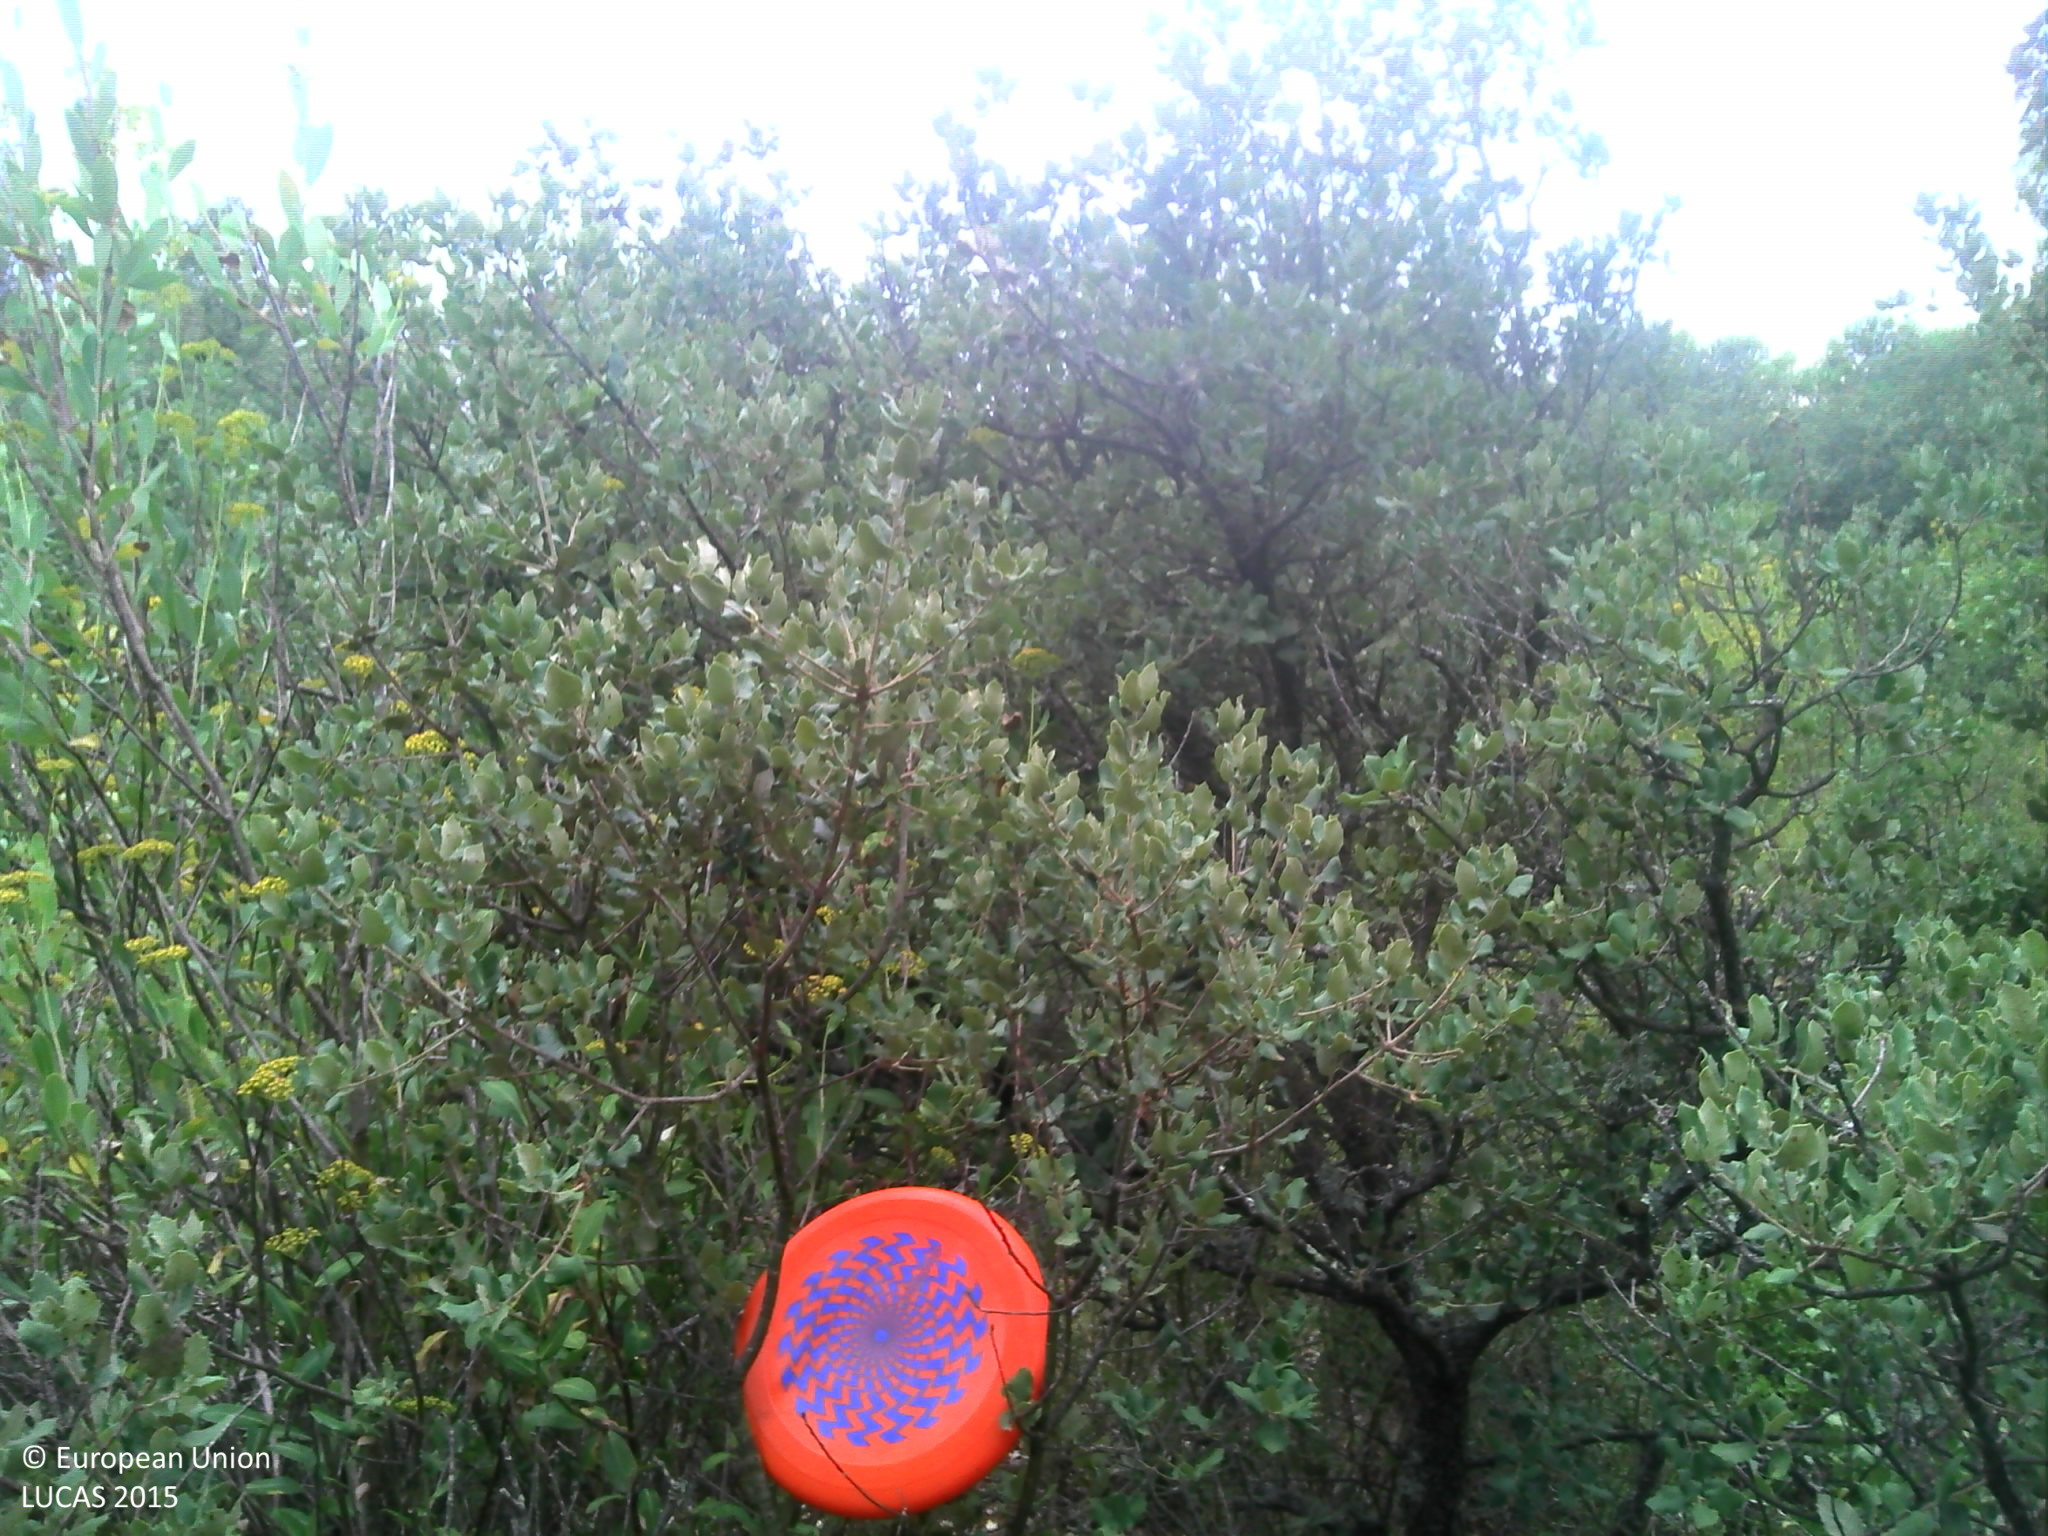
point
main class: Woodland
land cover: Broadleaved woodland
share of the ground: > 75 %
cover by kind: broadleaved forest trees 60 %, unconsolidated bare surface 20 %, shrubs 10 %, herbaceous plants 10 %
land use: Forestry
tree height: < 5 m
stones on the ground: 10 - 25 %
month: July
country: FR
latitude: 43.5816
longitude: 5.0436
